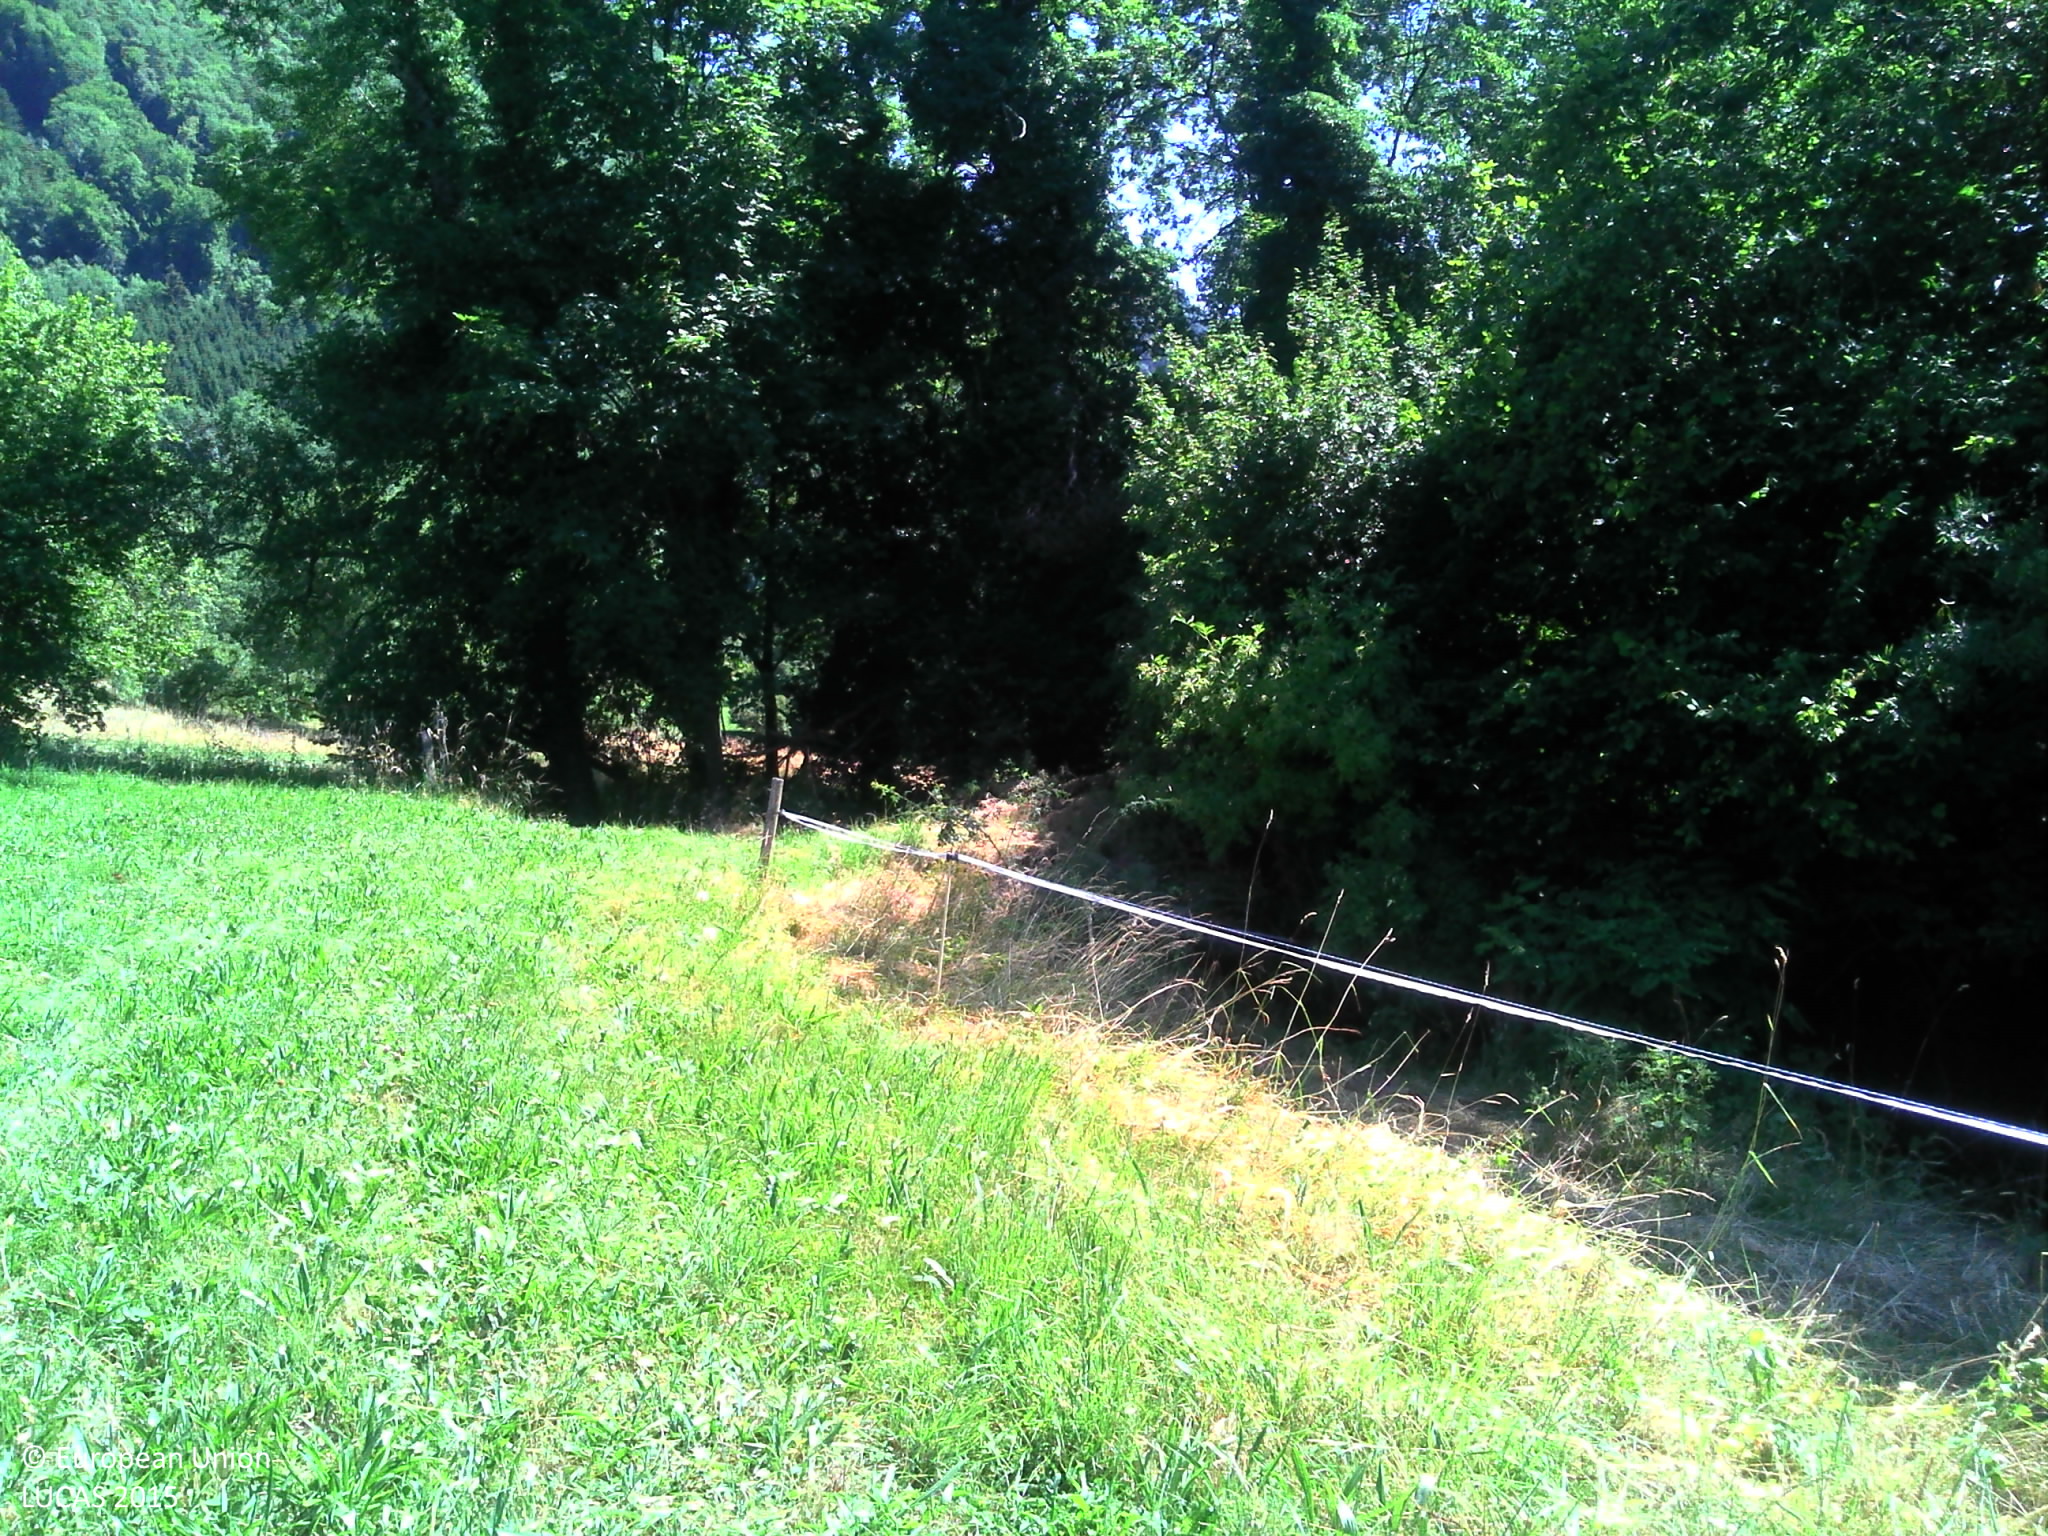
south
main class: Grassland
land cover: Grassland without tree/shrub cover
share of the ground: > 75 %
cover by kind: herbaceous plants 100 %
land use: Agriculture (excluding fallow land and kitchen gardens)
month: July
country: FR
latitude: 46.2926
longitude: 6.4595
